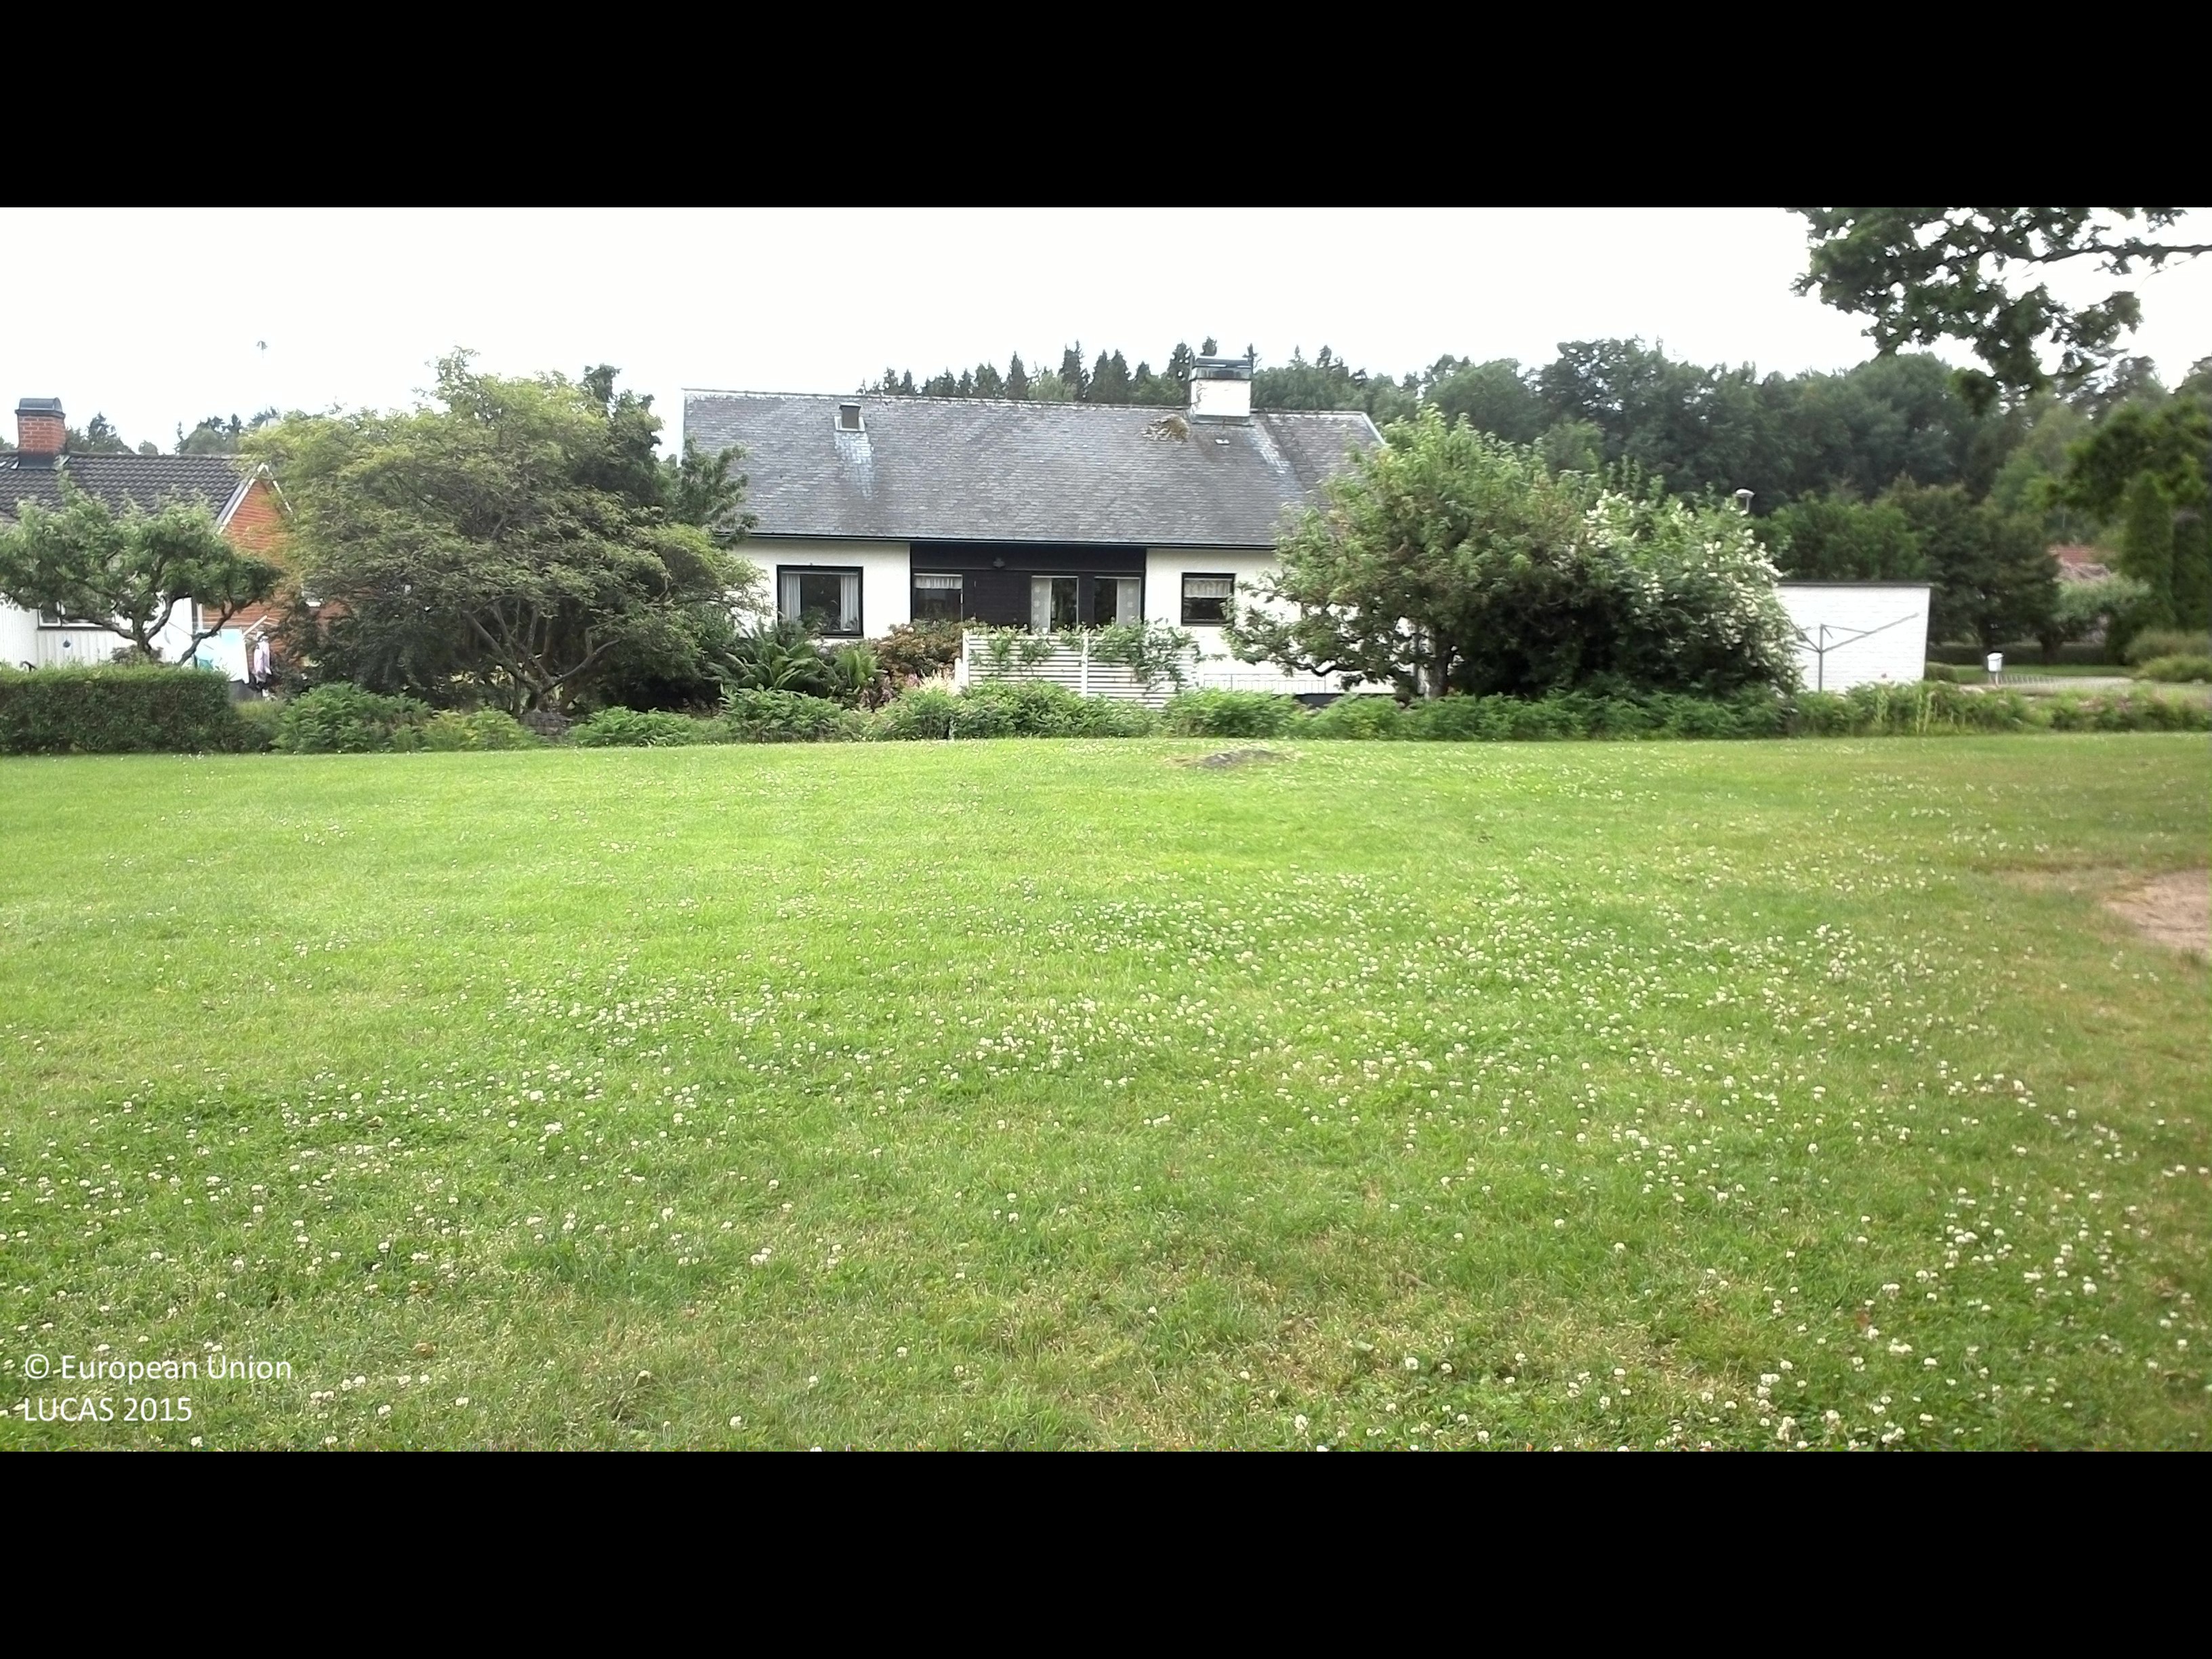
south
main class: Grassland
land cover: Grassland without tree/shrub cover
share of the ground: > 75 %
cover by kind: herbaceous plants 100 %
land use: Amenities, museums, leisure
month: July
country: SE
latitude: 56.4624
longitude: 14.6880
